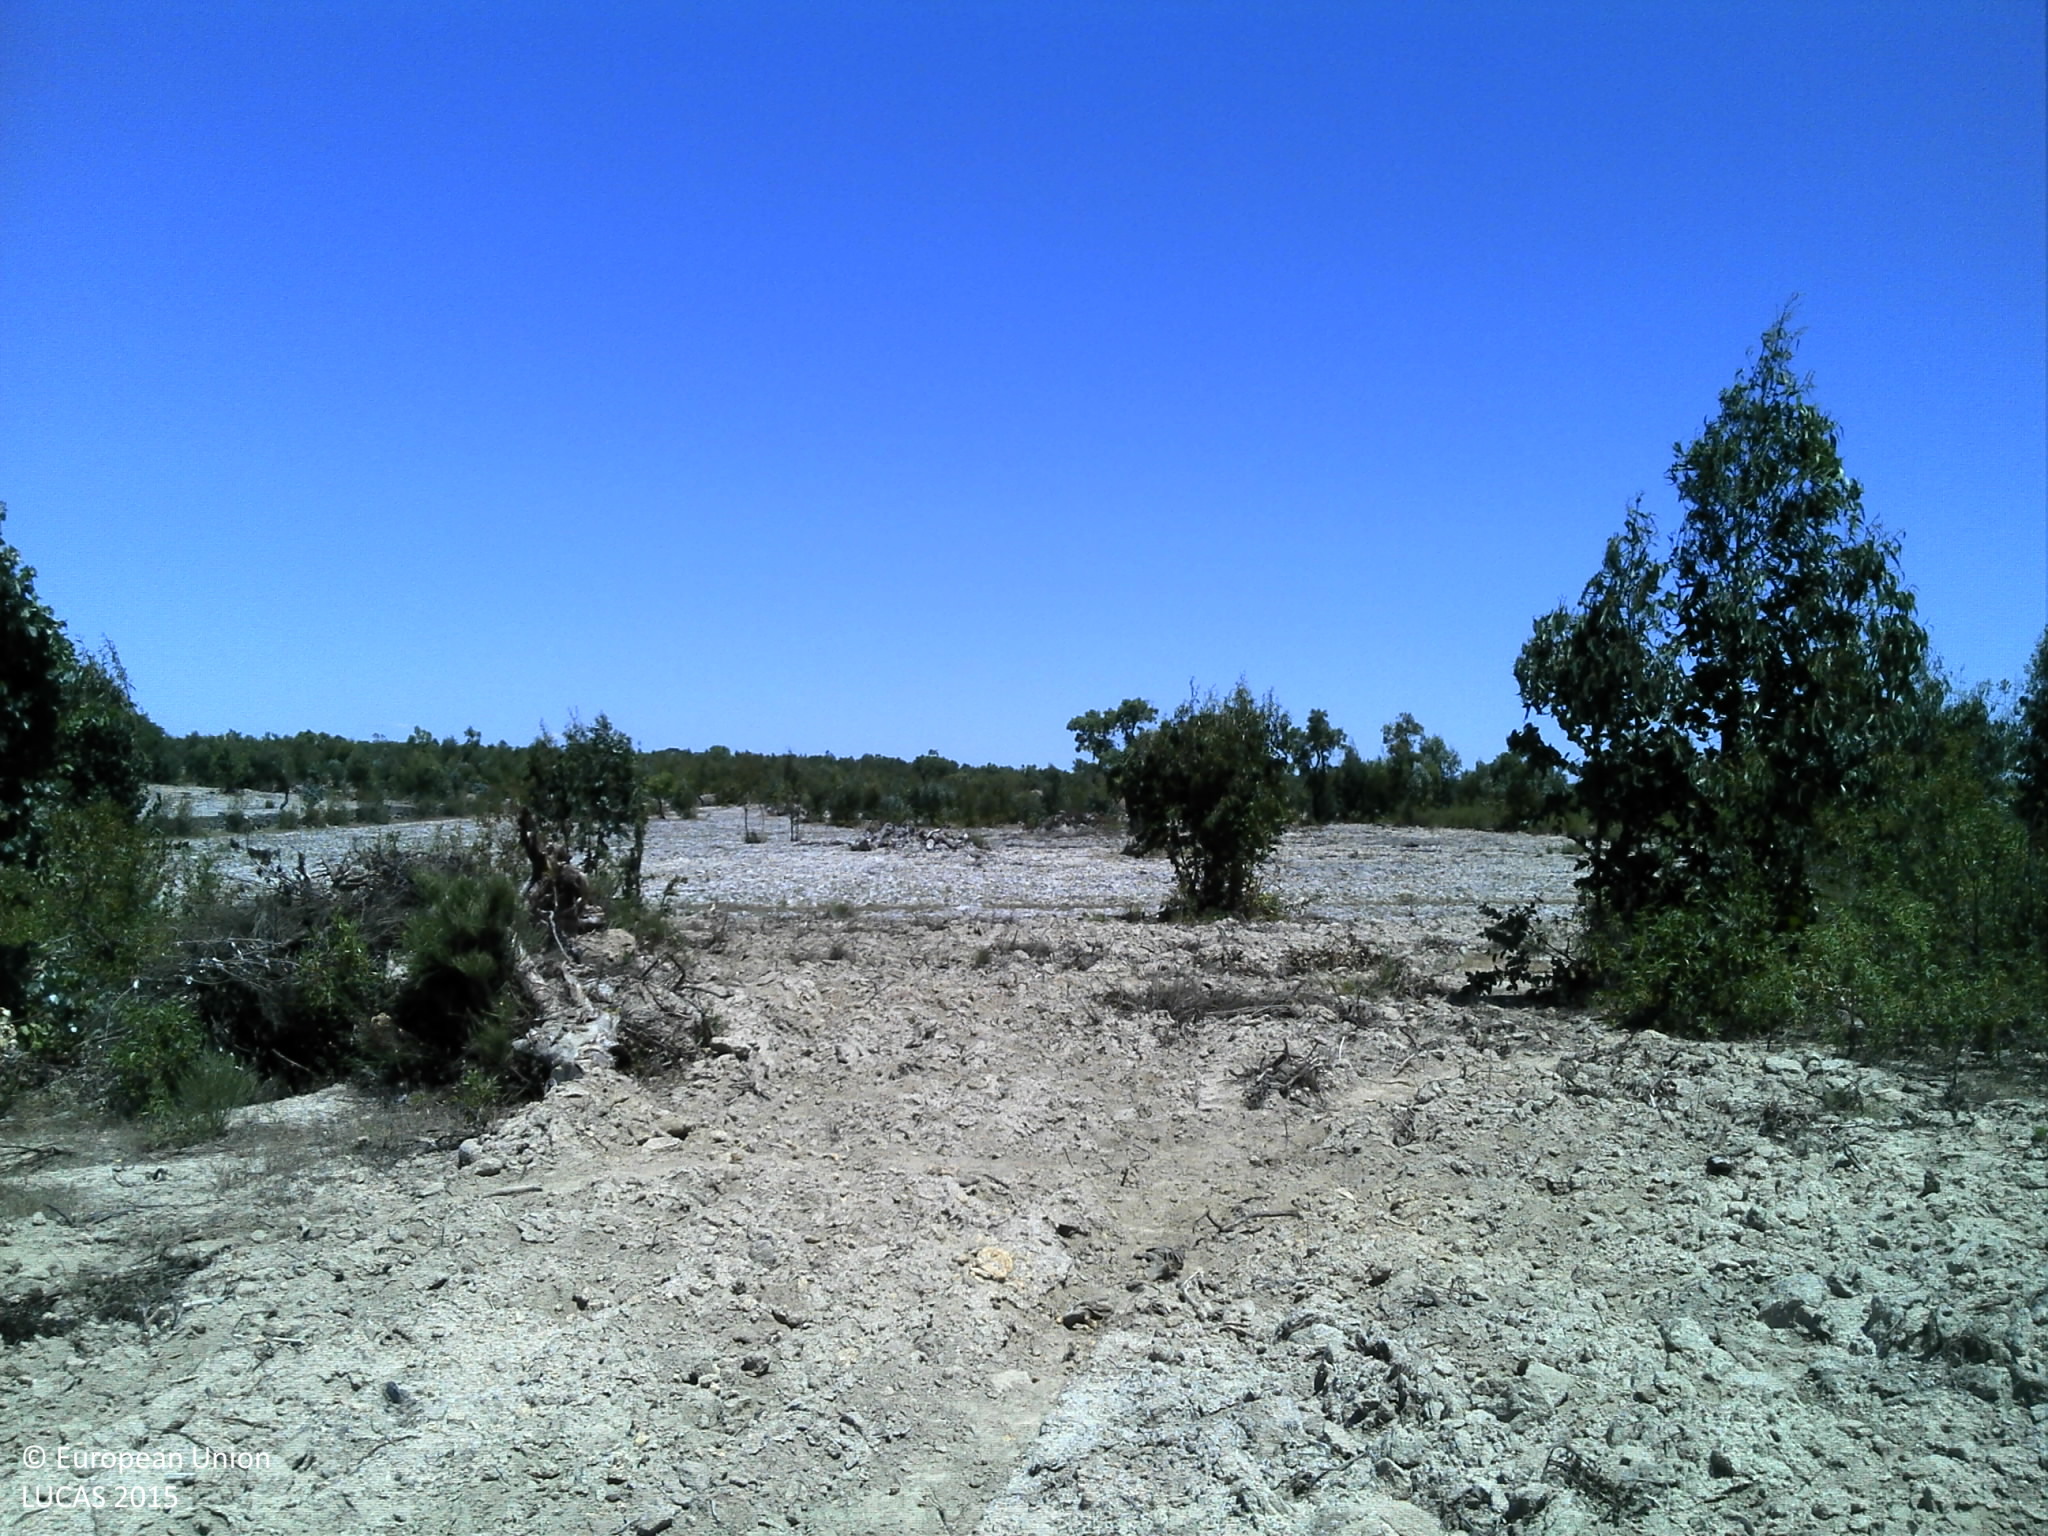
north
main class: Woodland
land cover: Broadleaved woodland
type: exotic forest
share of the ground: 10 - 25 %
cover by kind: unconsolidated bare surface 90 %, broadleaved forest trees 10 %
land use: Forestry
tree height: > 5 m
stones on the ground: < 10 %
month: May
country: PT
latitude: 39.4554
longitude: -7.7041
